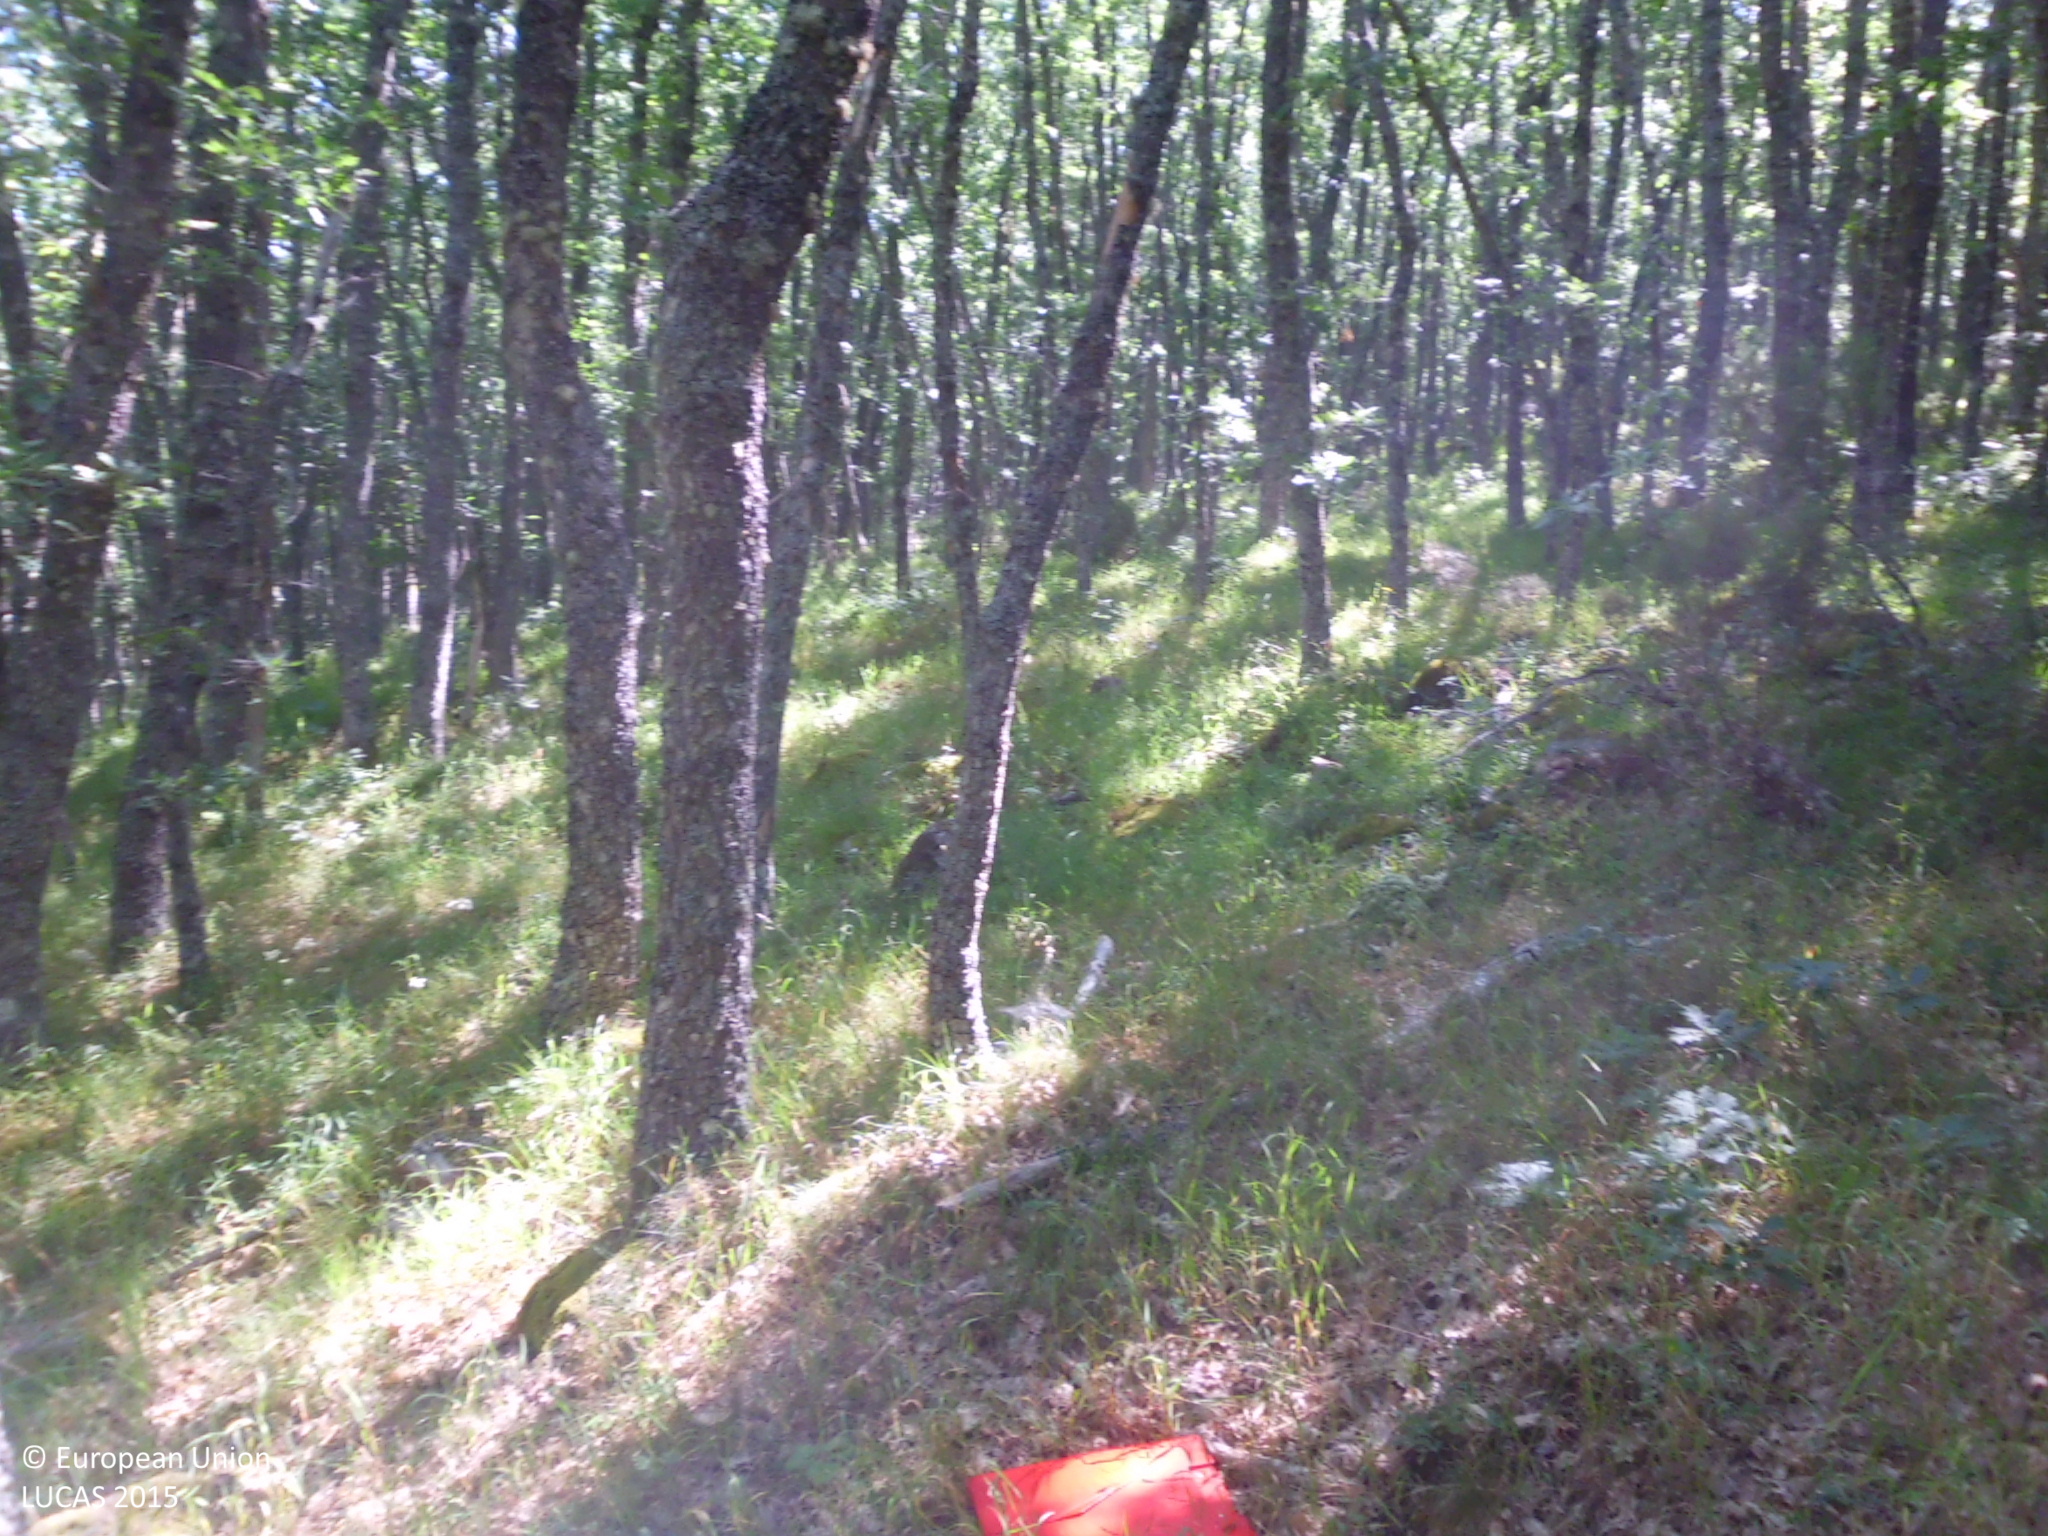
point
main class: Woodland
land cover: Broadleaved woodland
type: acidophilous oak and oak-birch forest
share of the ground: > 75 %
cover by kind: broadleaved forest trees 100 %
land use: Semi-natural and natural areas not in use
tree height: > 5 m
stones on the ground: 10 - 25 %
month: July
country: ES
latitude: 42.2268
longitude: -3.3207
